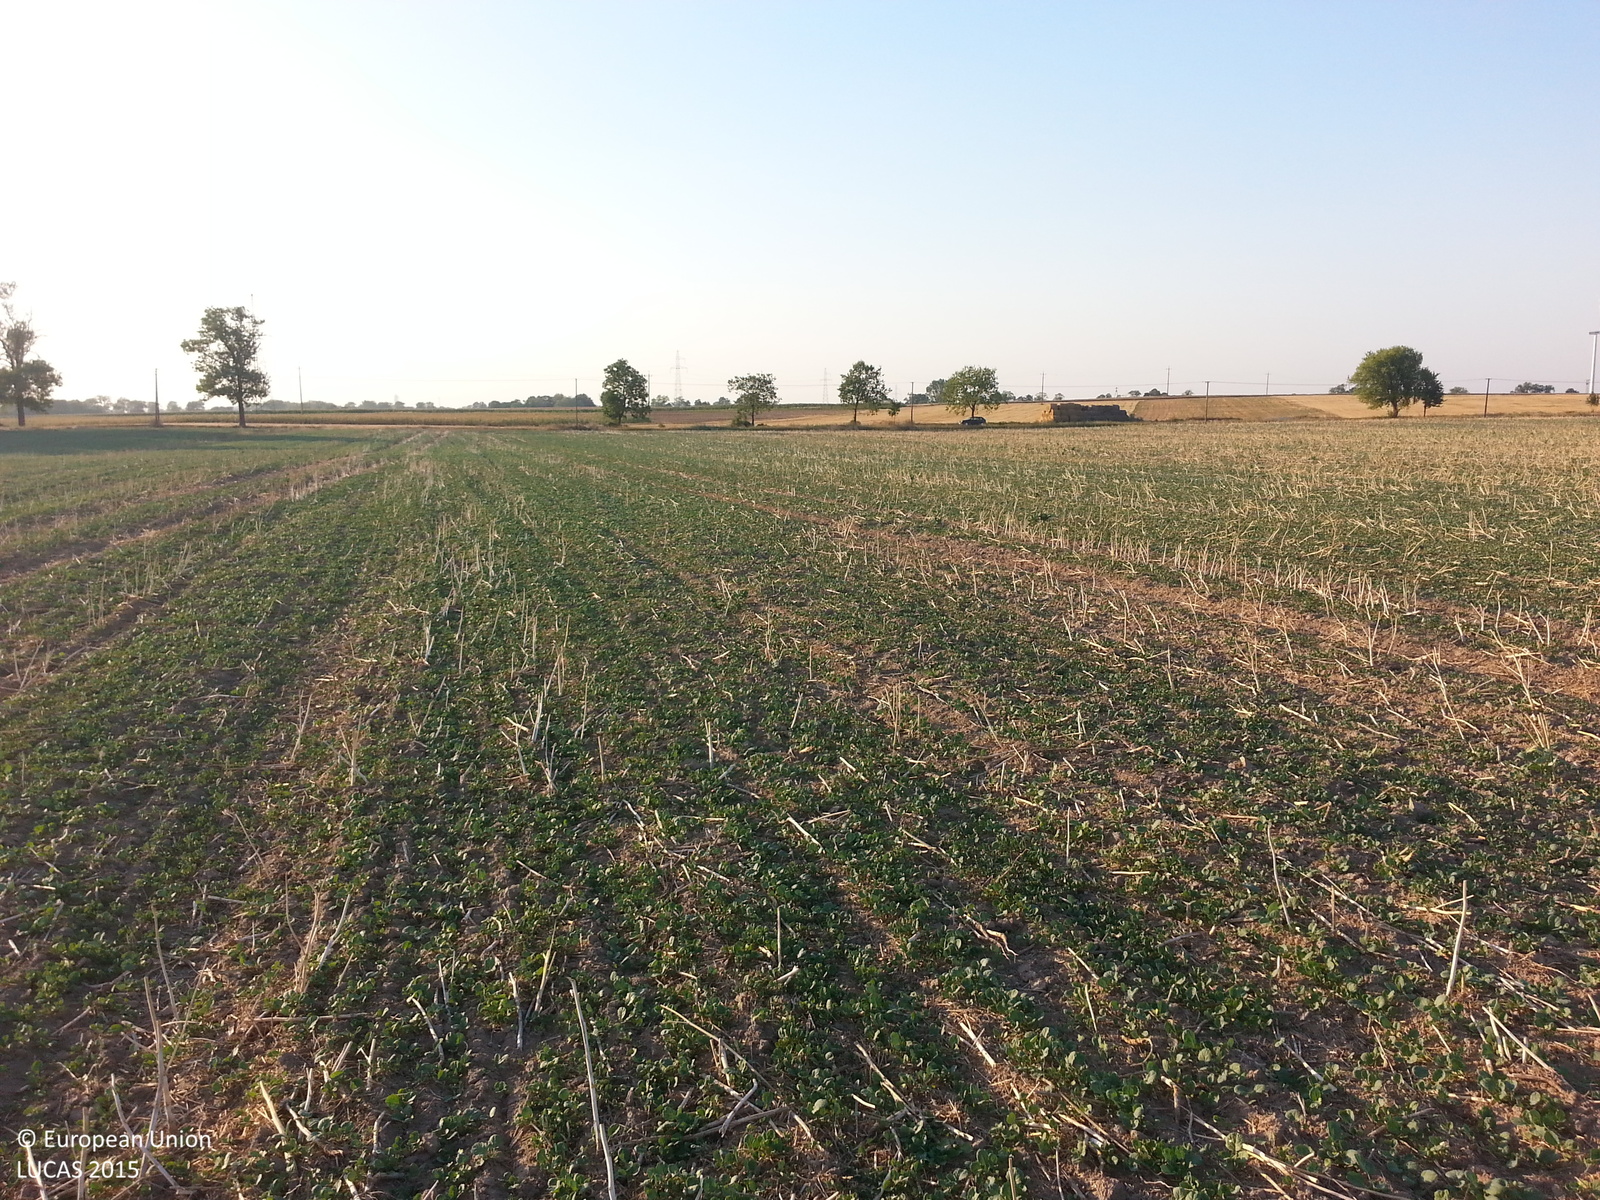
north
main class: Cropland
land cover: Rape and turnip rape
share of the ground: 25 - 50 %
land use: Agriculture (excluding fallow land and kitchen gardens)
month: August
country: PL
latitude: 52.7714
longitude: 18.0643
